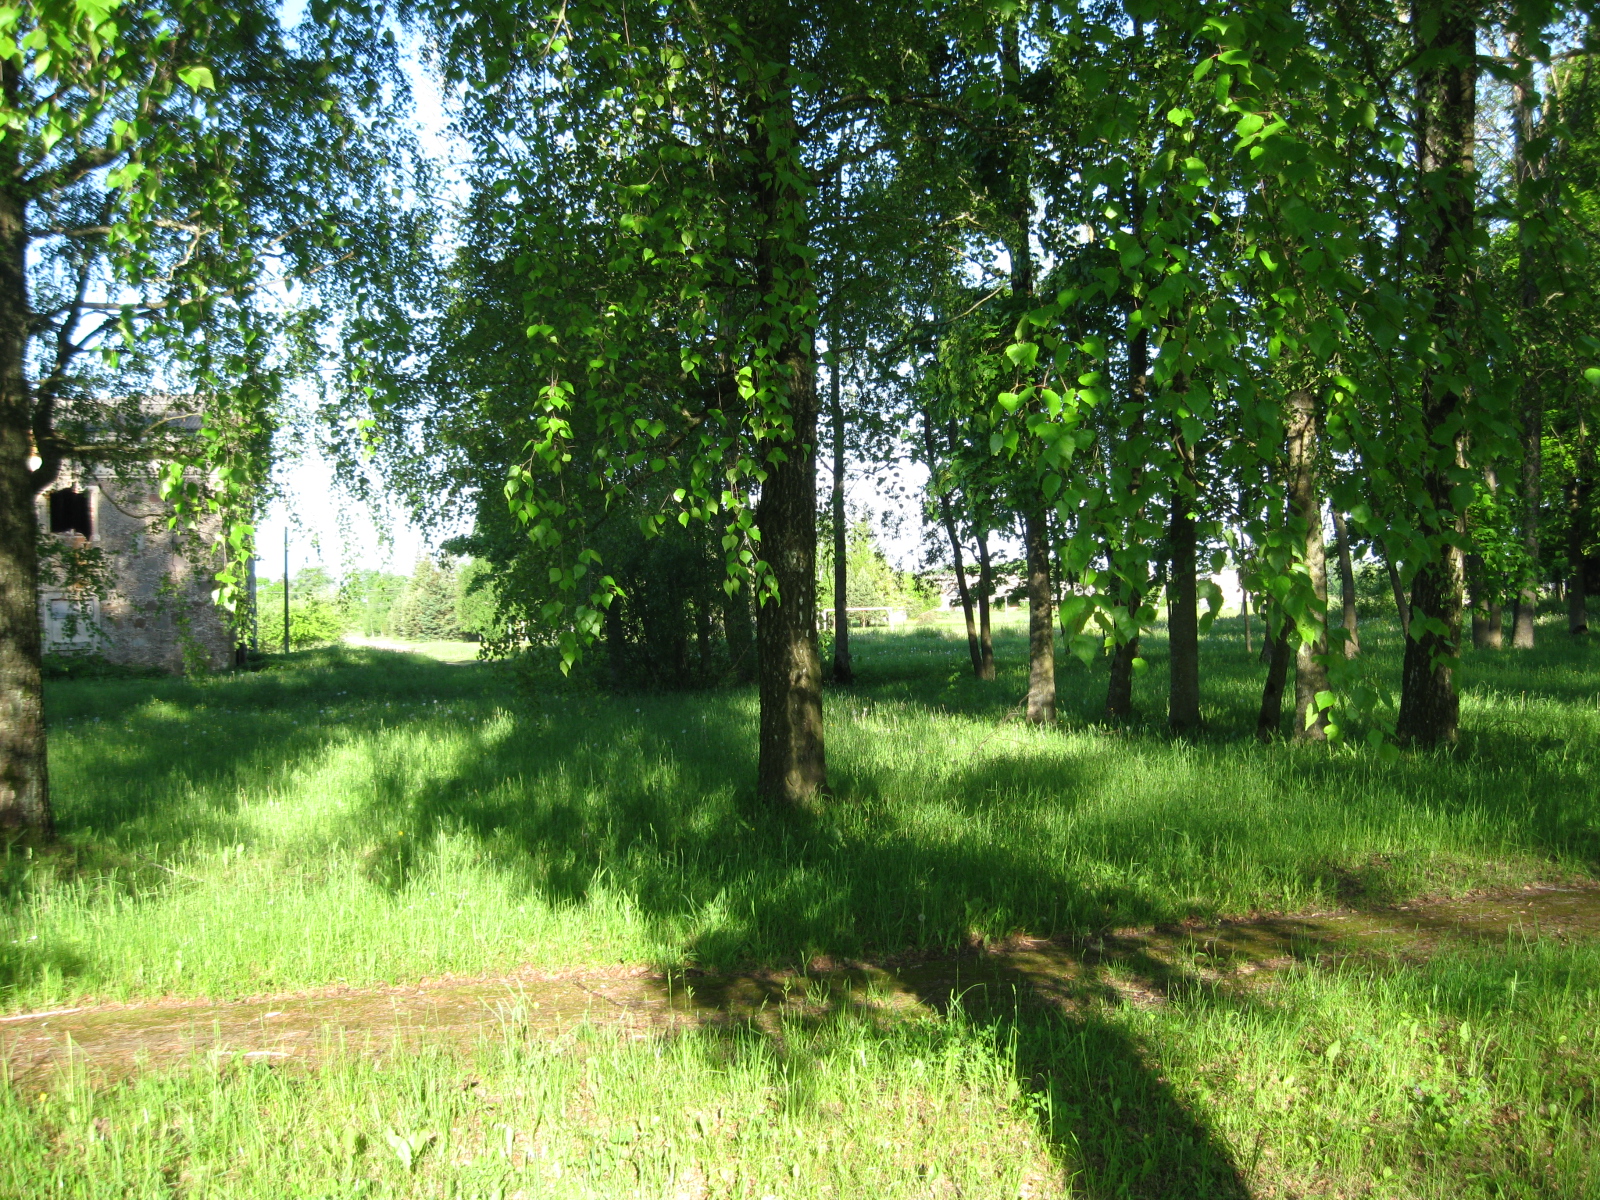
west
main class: Woodland
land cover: Broadleaved woodland
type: non-riverine alder, birch or aspen forest
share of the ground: 50 - 75 %
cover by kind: broadleaved forest trees 55 %, herbaceous plants 45 %
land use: Amenities, museums, leisure
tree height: > 5 m
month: May
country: LT
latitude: 55.9081
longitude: 24.8066
